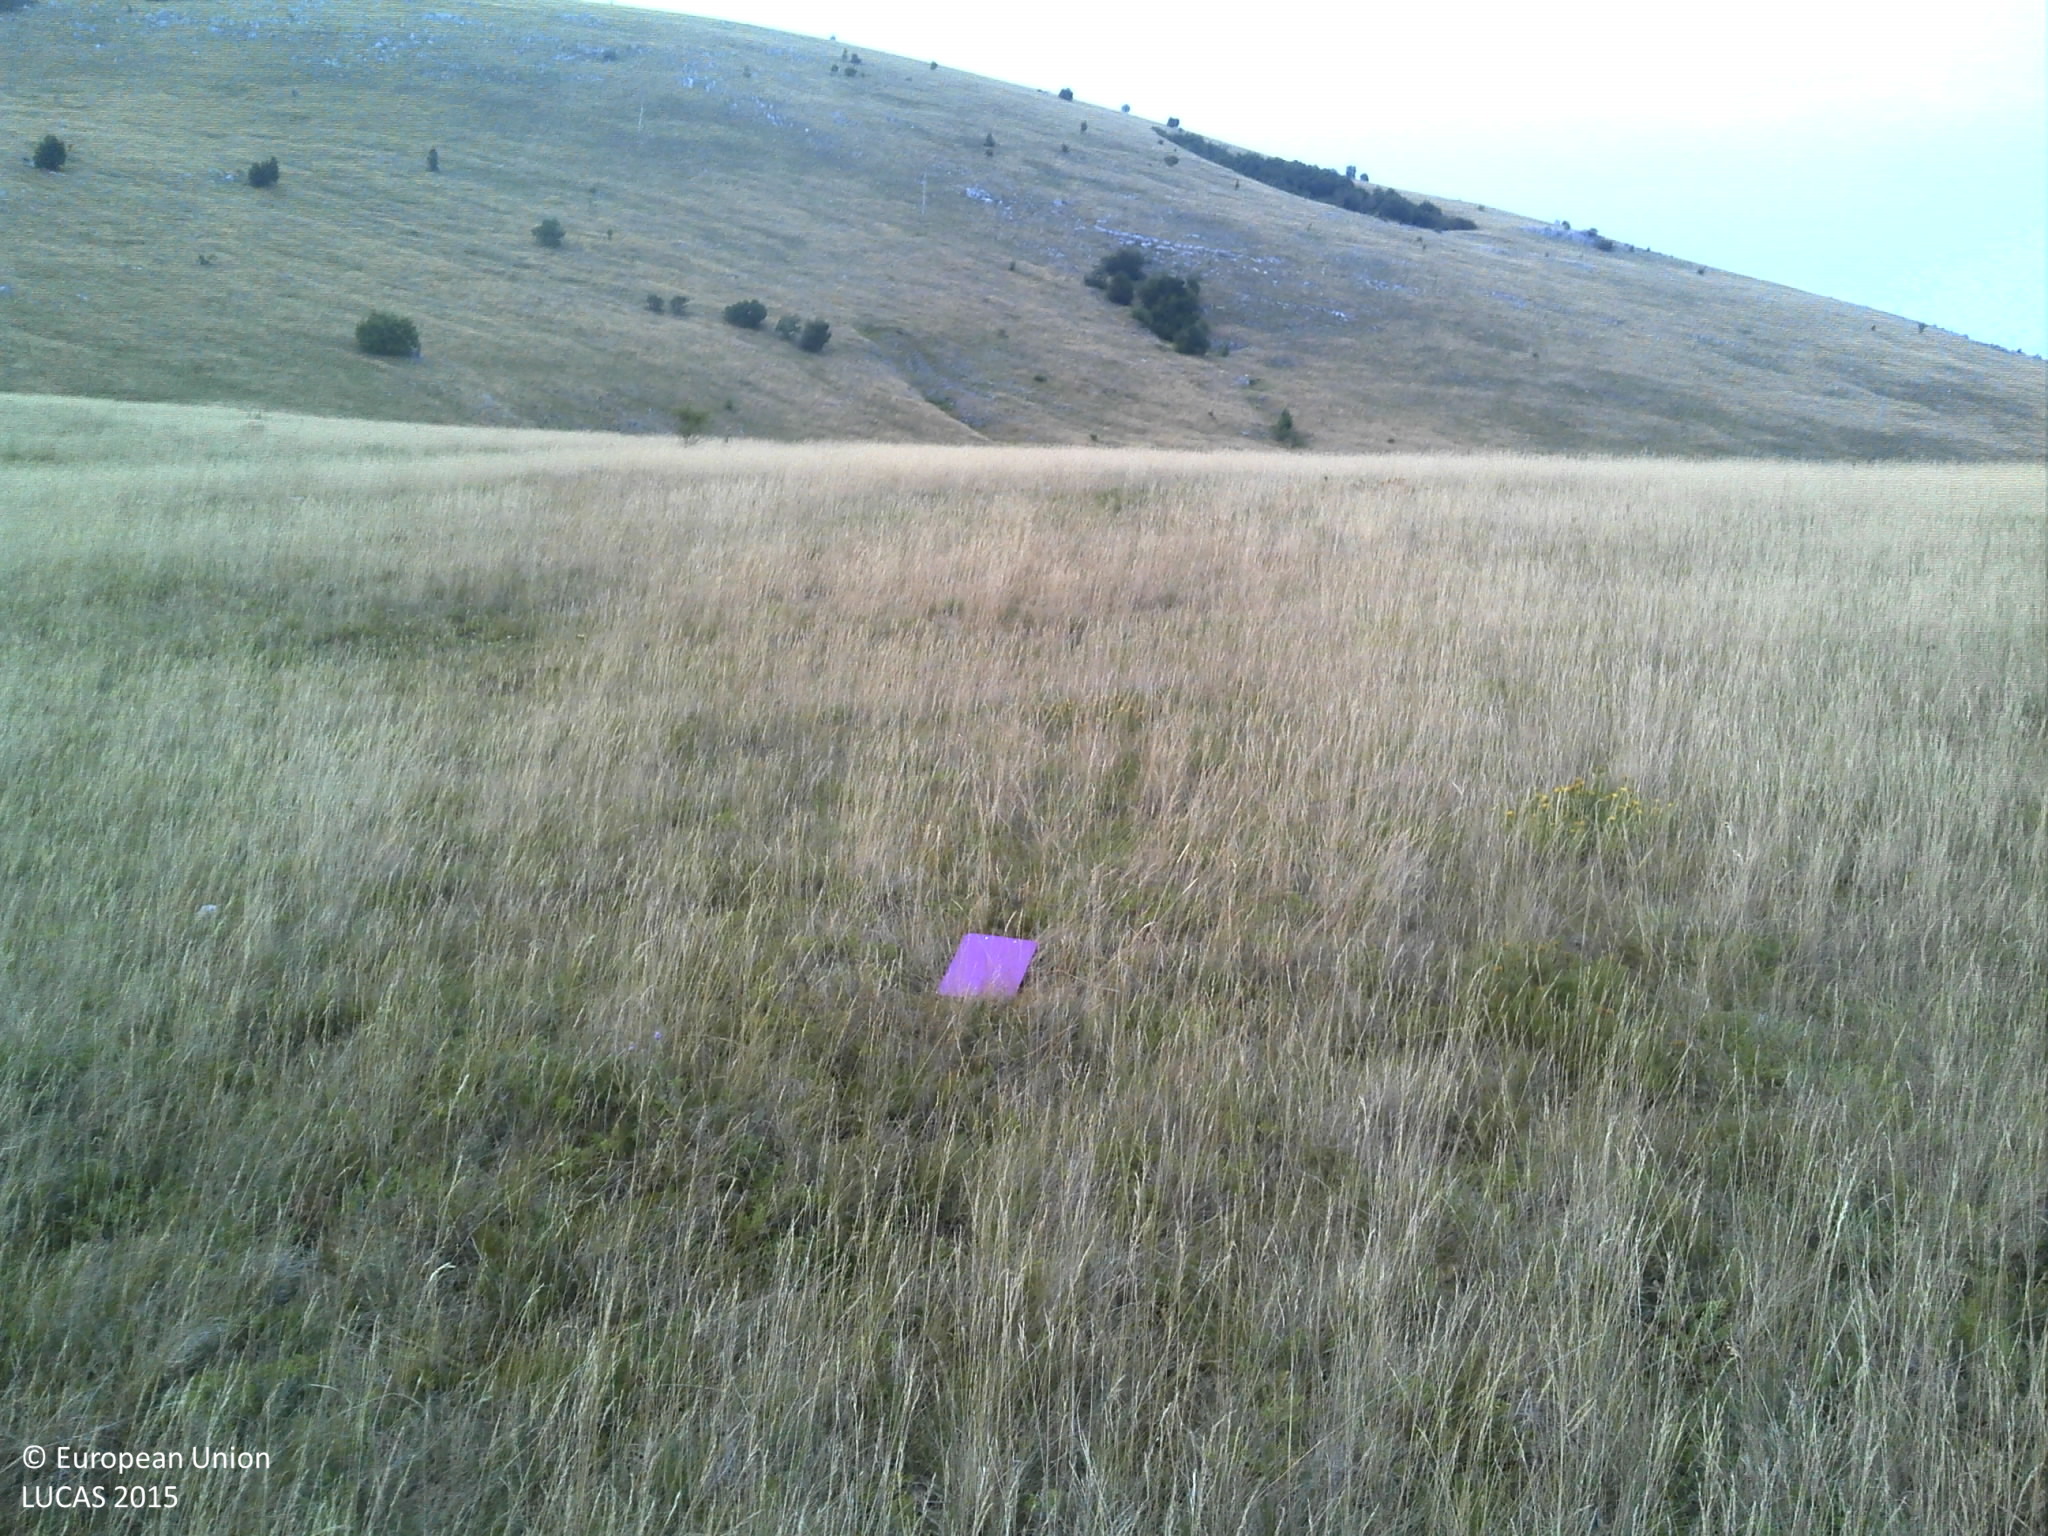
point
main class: Grassland
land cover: Grassland without tree/shrub cover
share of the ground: > 75 %
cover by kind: herbaceous plants 95 %, shrubs 5 %
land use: Abandoned areas
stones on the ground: < 10 %
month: July
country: HR
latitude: 44.2289
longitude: 16.0397
